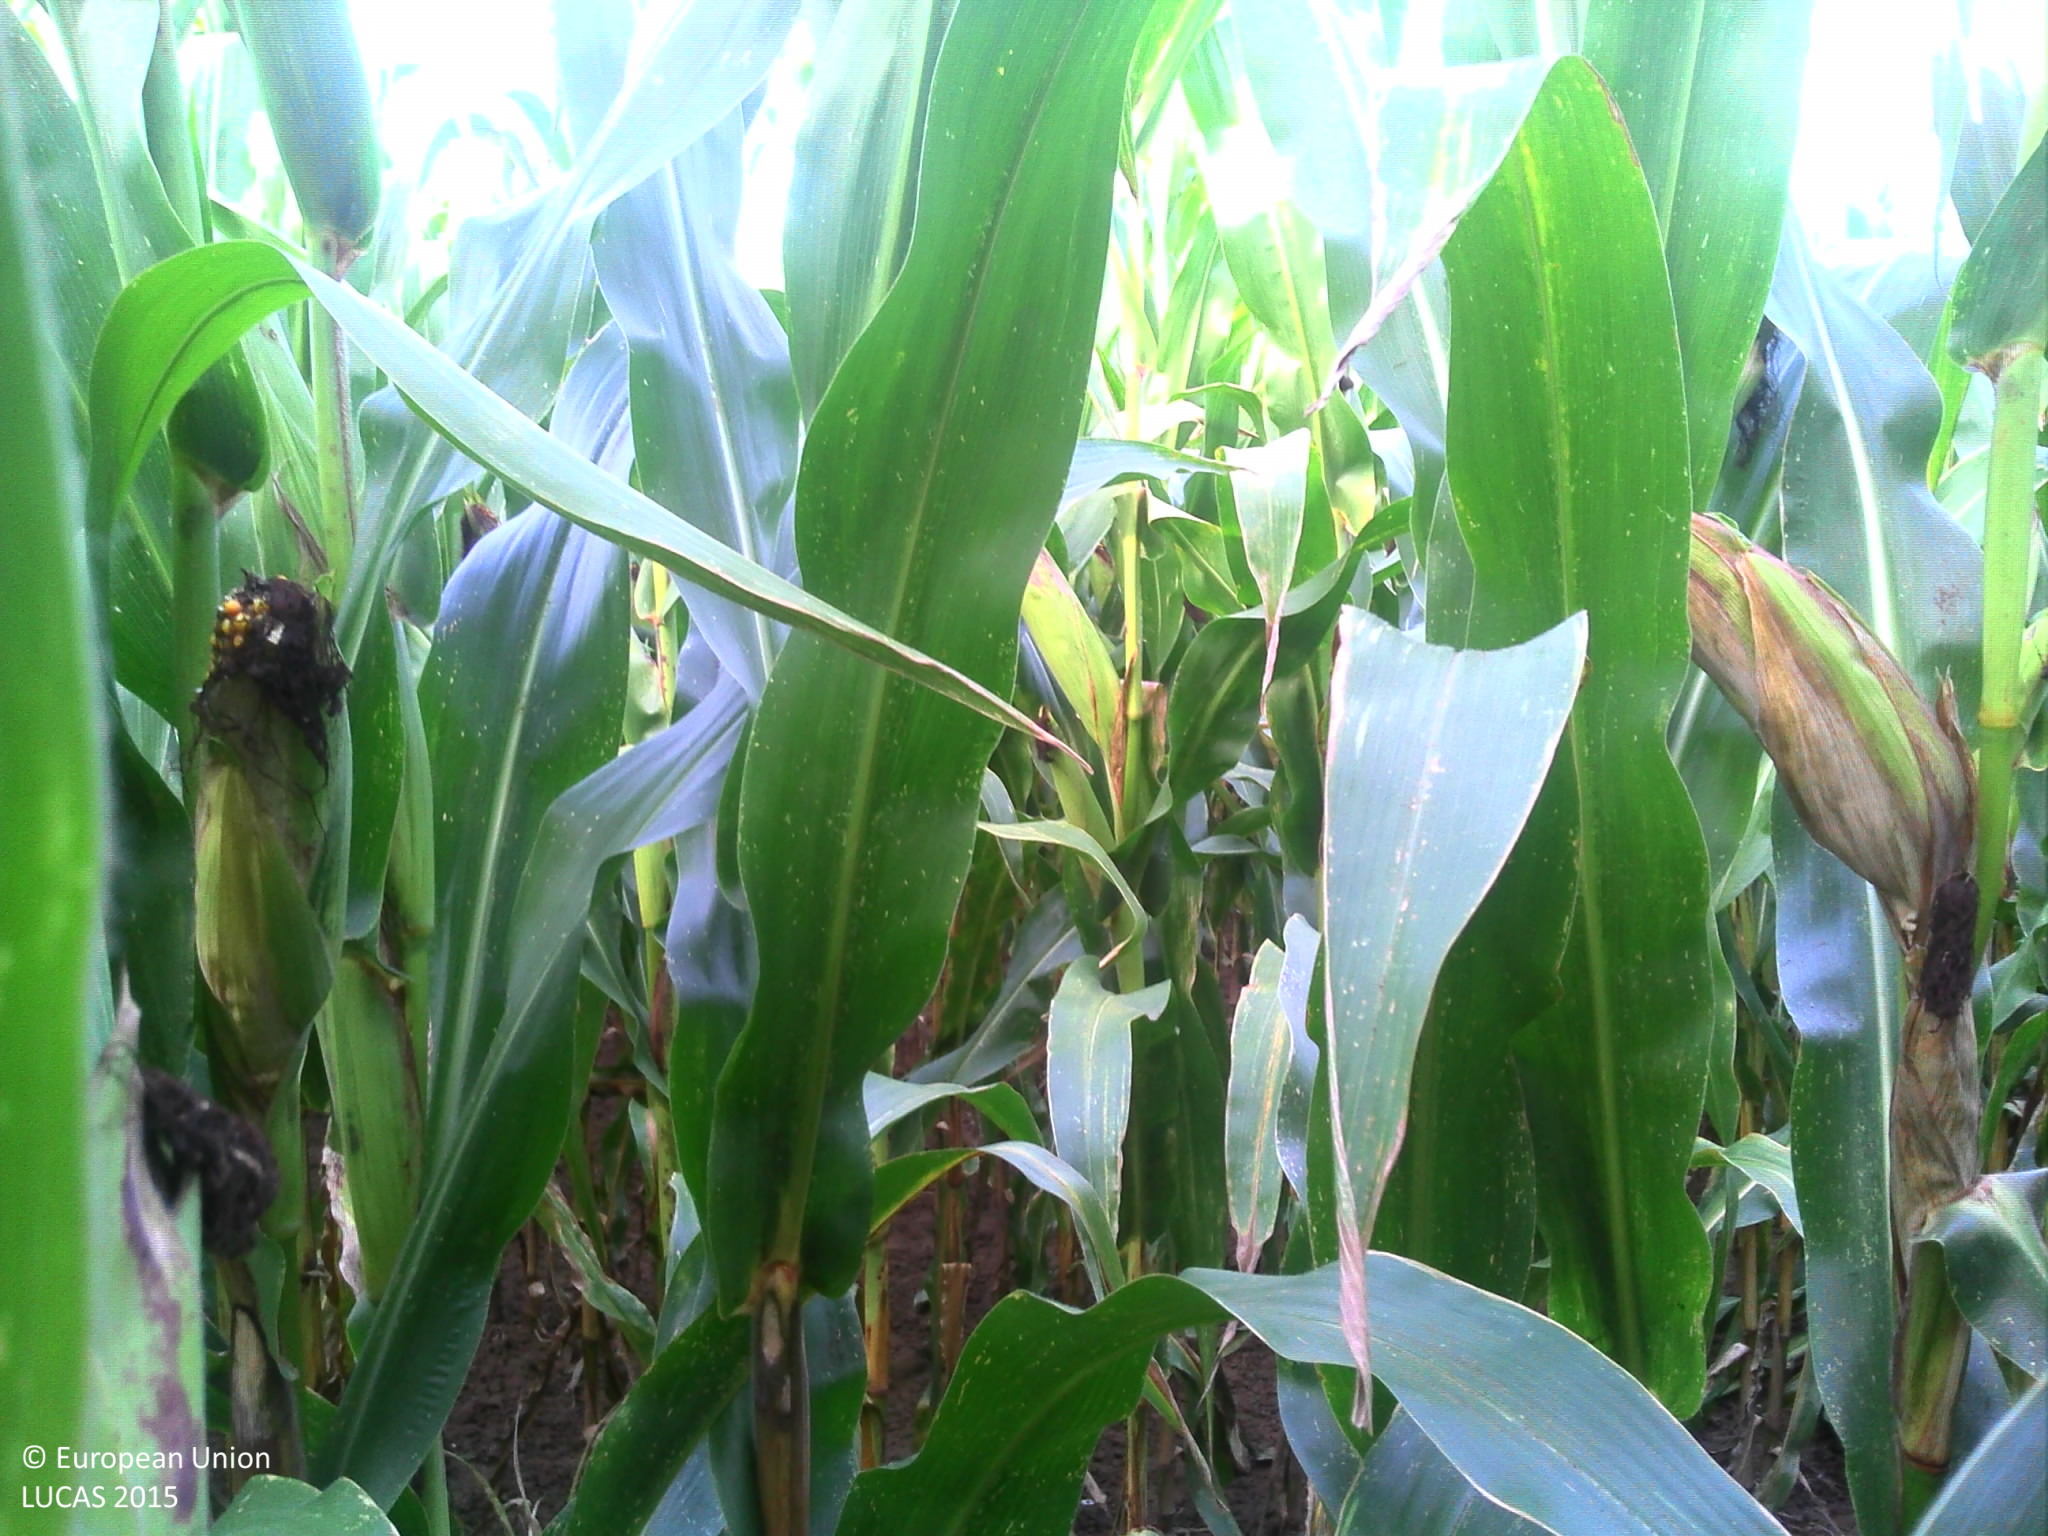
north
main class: Cropland
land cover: Maize
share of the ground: > 75 %
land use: Agriculture (excluding fallow land and kitchen gardens)
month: September
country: FR
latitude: 48.5026
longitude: 6.8471
